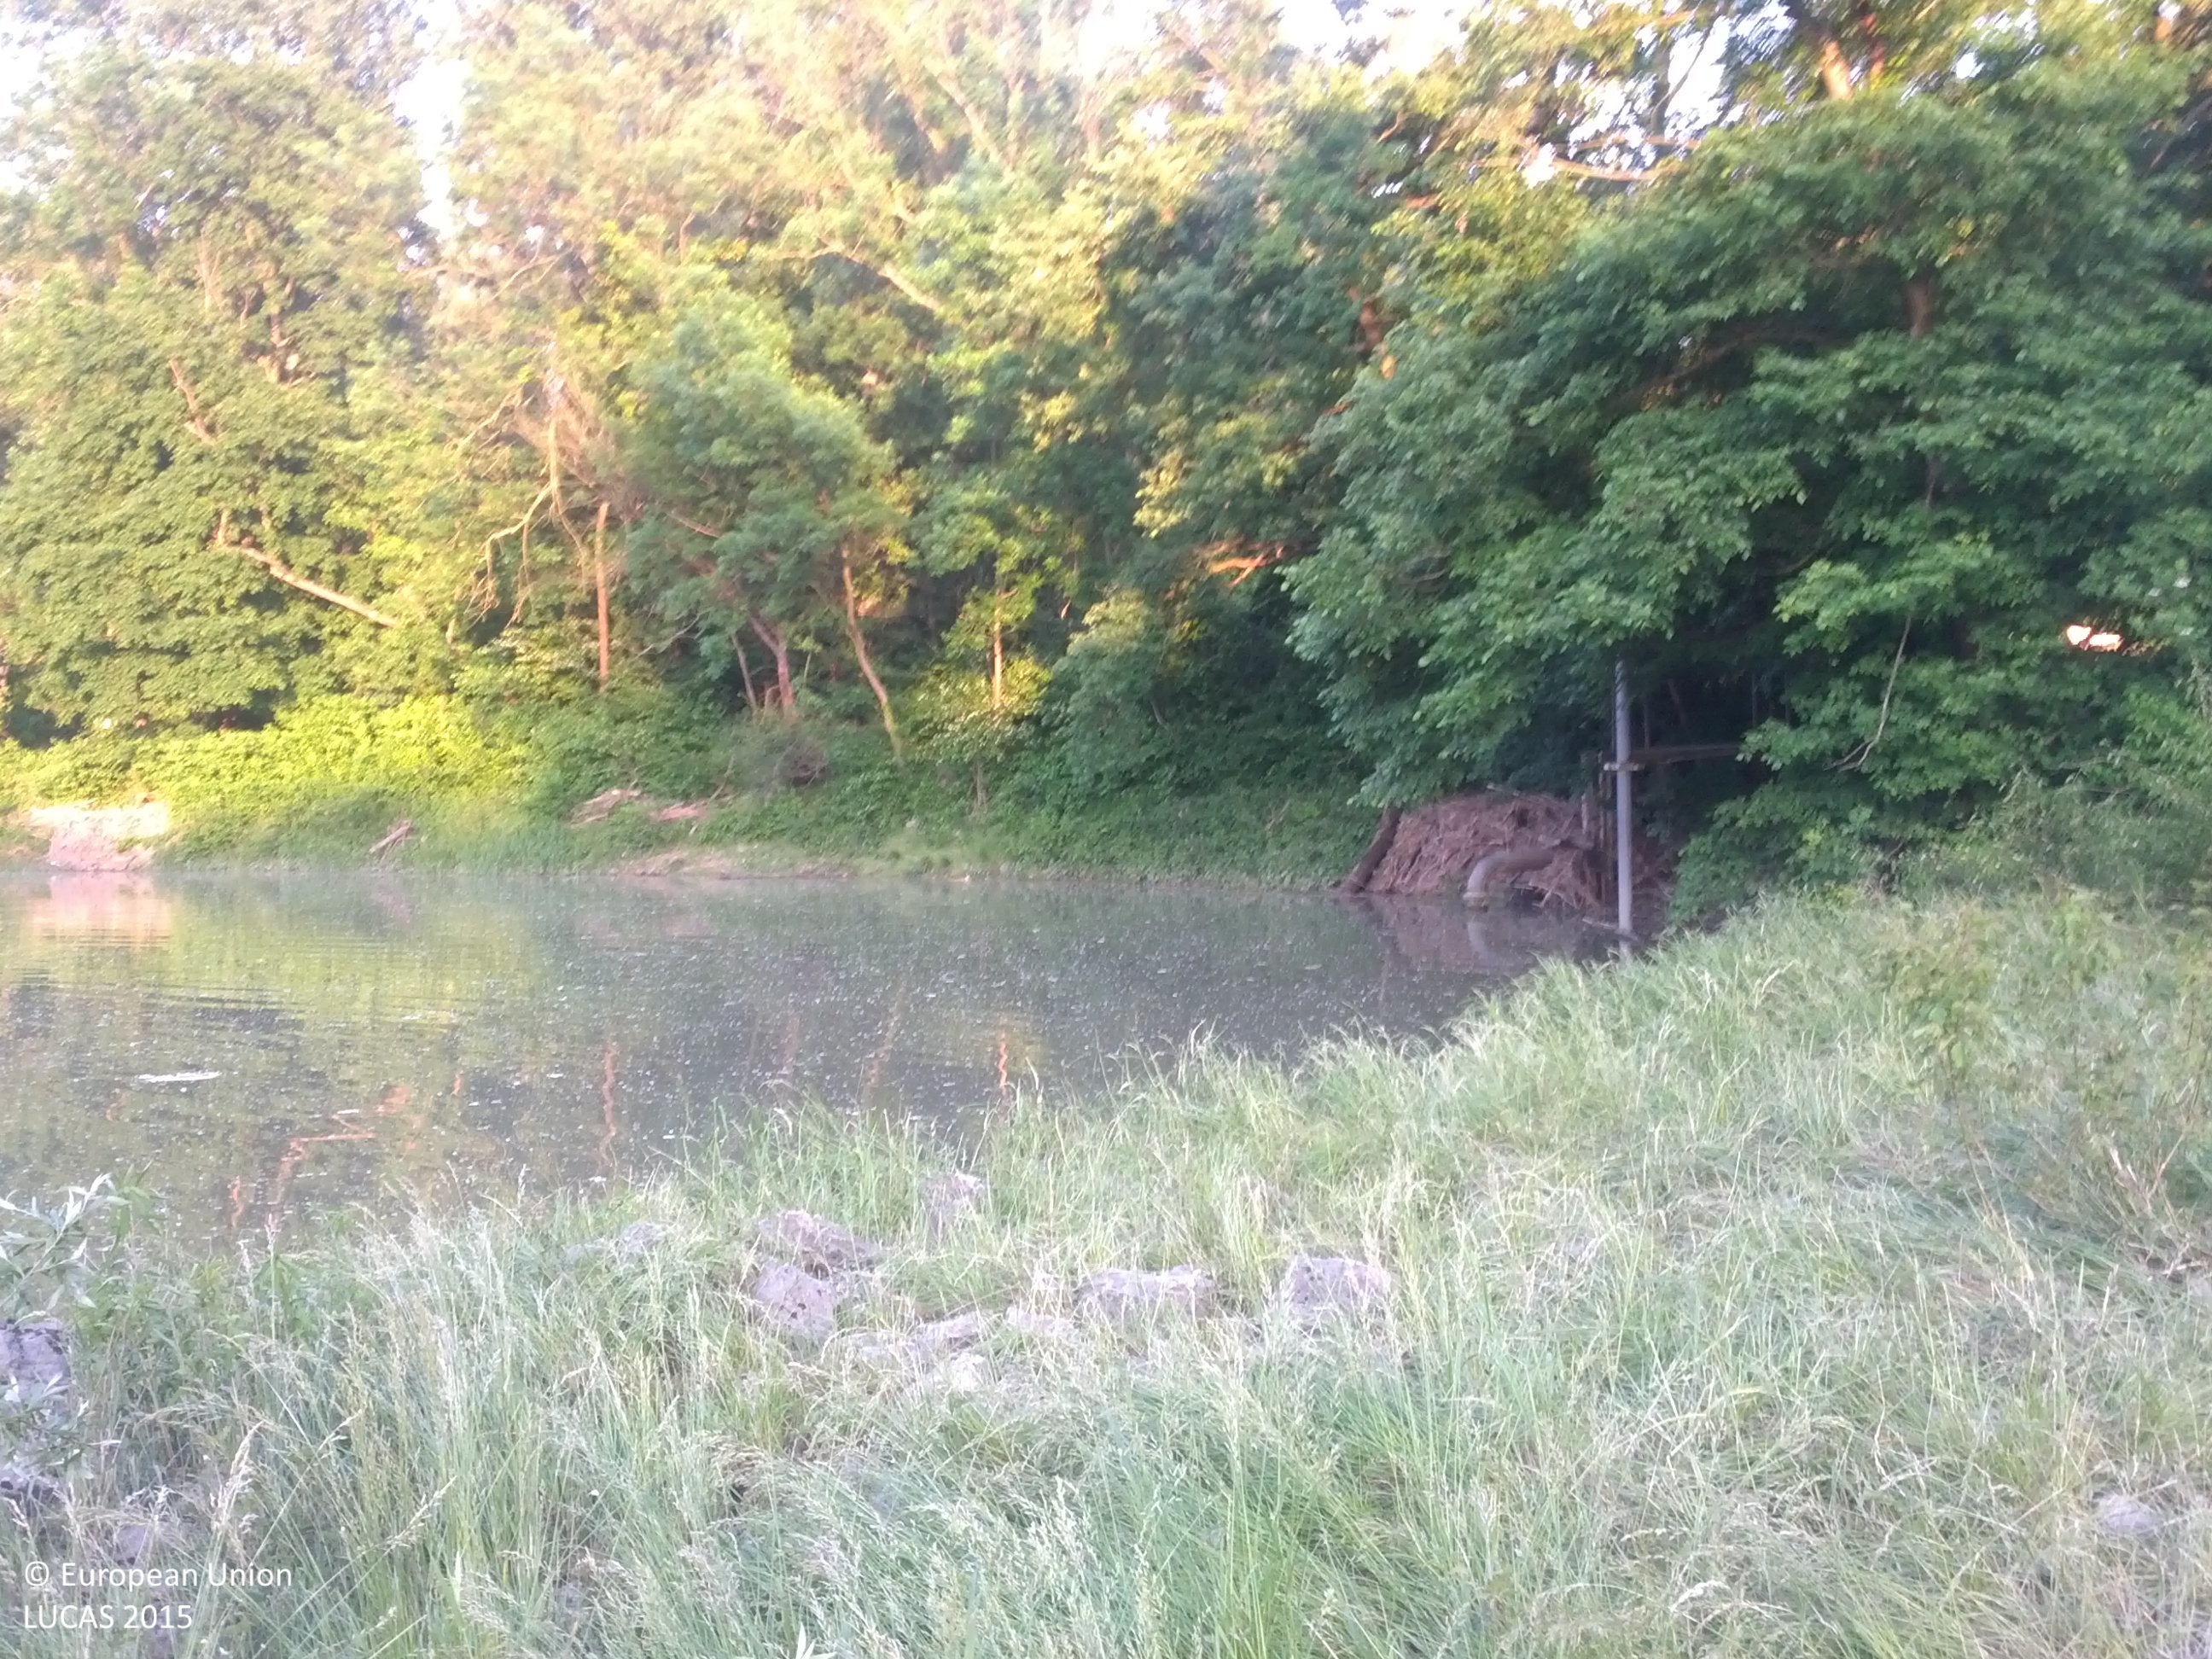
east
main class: Shrubland
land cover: Shrubland with sparse tree cover
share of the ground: 50 - 75 %
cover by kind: shrubs 55 %, herbaceous plants 30 %, broadleaved forest trees 5 %, consolidated bare surface 5 %, unconsolidated bare surface 5 %
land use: Semi-natural and natural areas not in use
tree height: > 5 m
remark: Temporary flooded
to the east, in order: Shrubland with sparse tree cover; Broadleaved woodland; Rocks and stones; Inland fresh running water; Rocks and stones; Broadleaved woodland
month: May
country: AT
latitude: 48.1191
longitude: 16.8443
